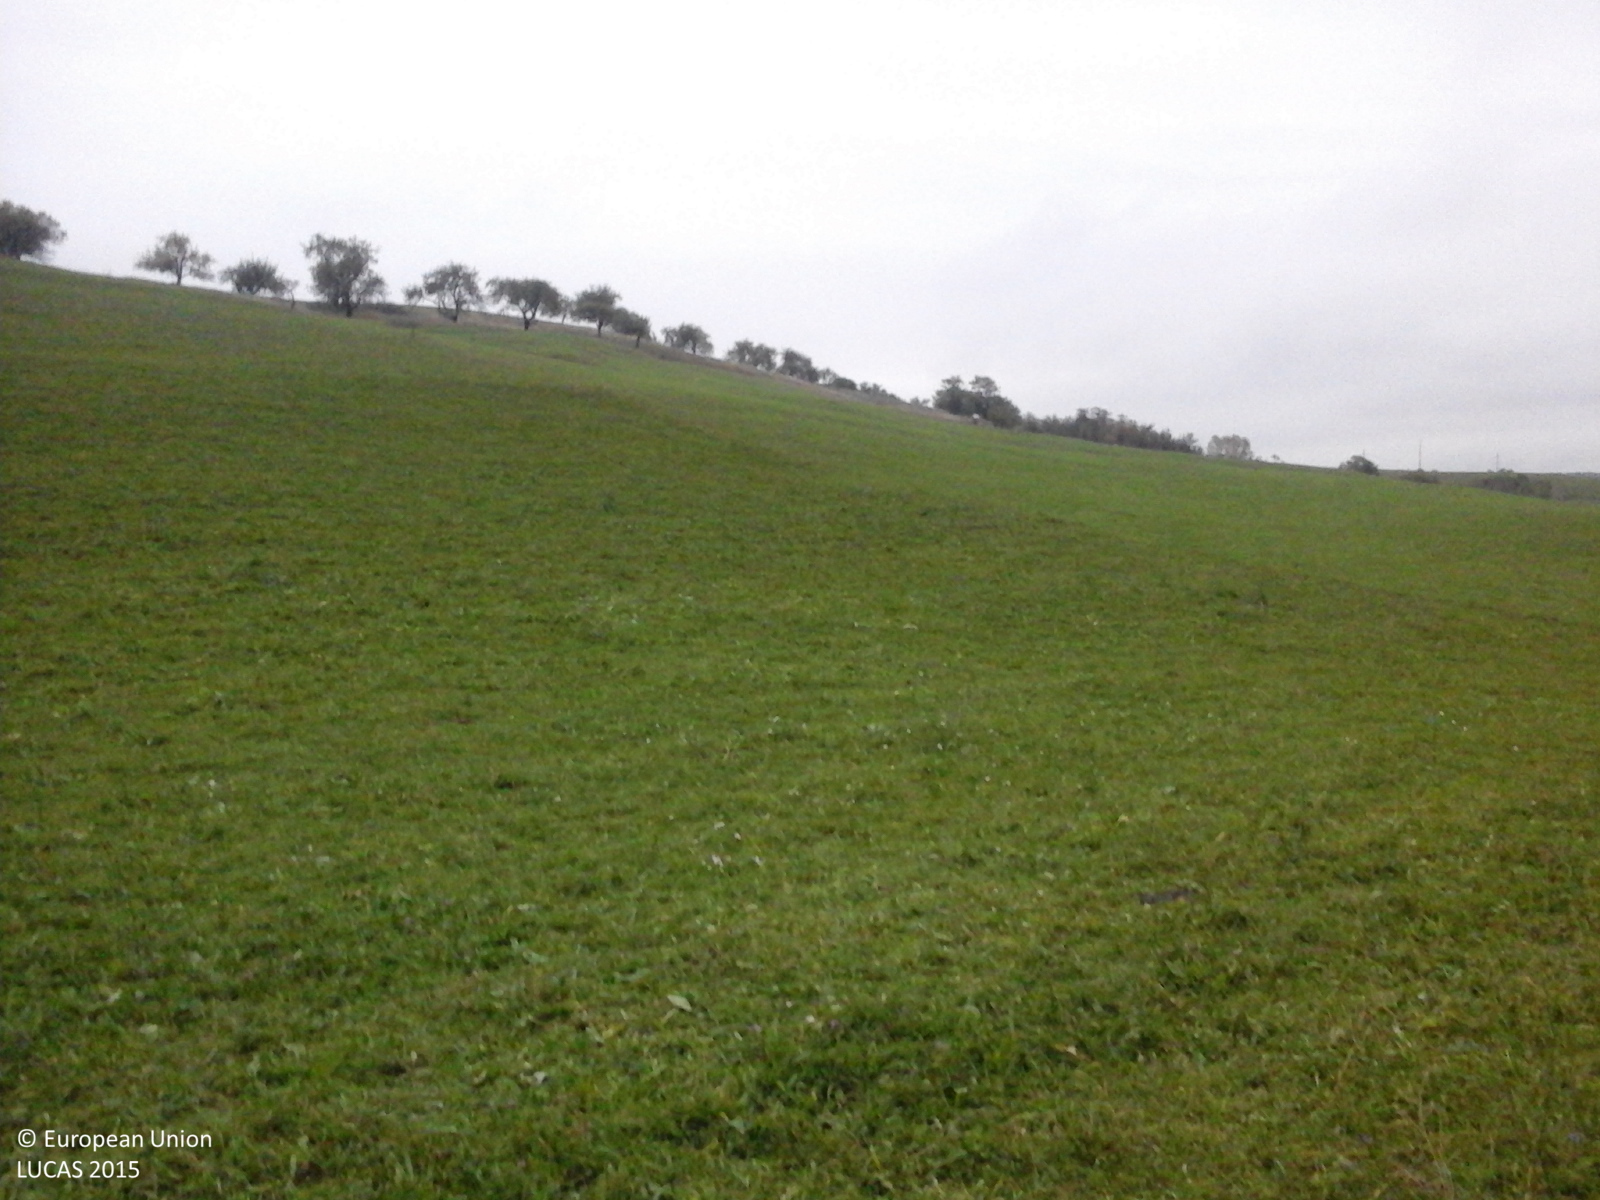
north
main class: Grassland
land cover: Grassland without tree/shrub cover
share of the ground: > 75 %
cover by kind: herbaceous plants 100 %
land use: Agriculture (excluding fallow land and kitchen gardens)
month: October
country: RO
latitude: 45.6955
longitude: 24.1622
